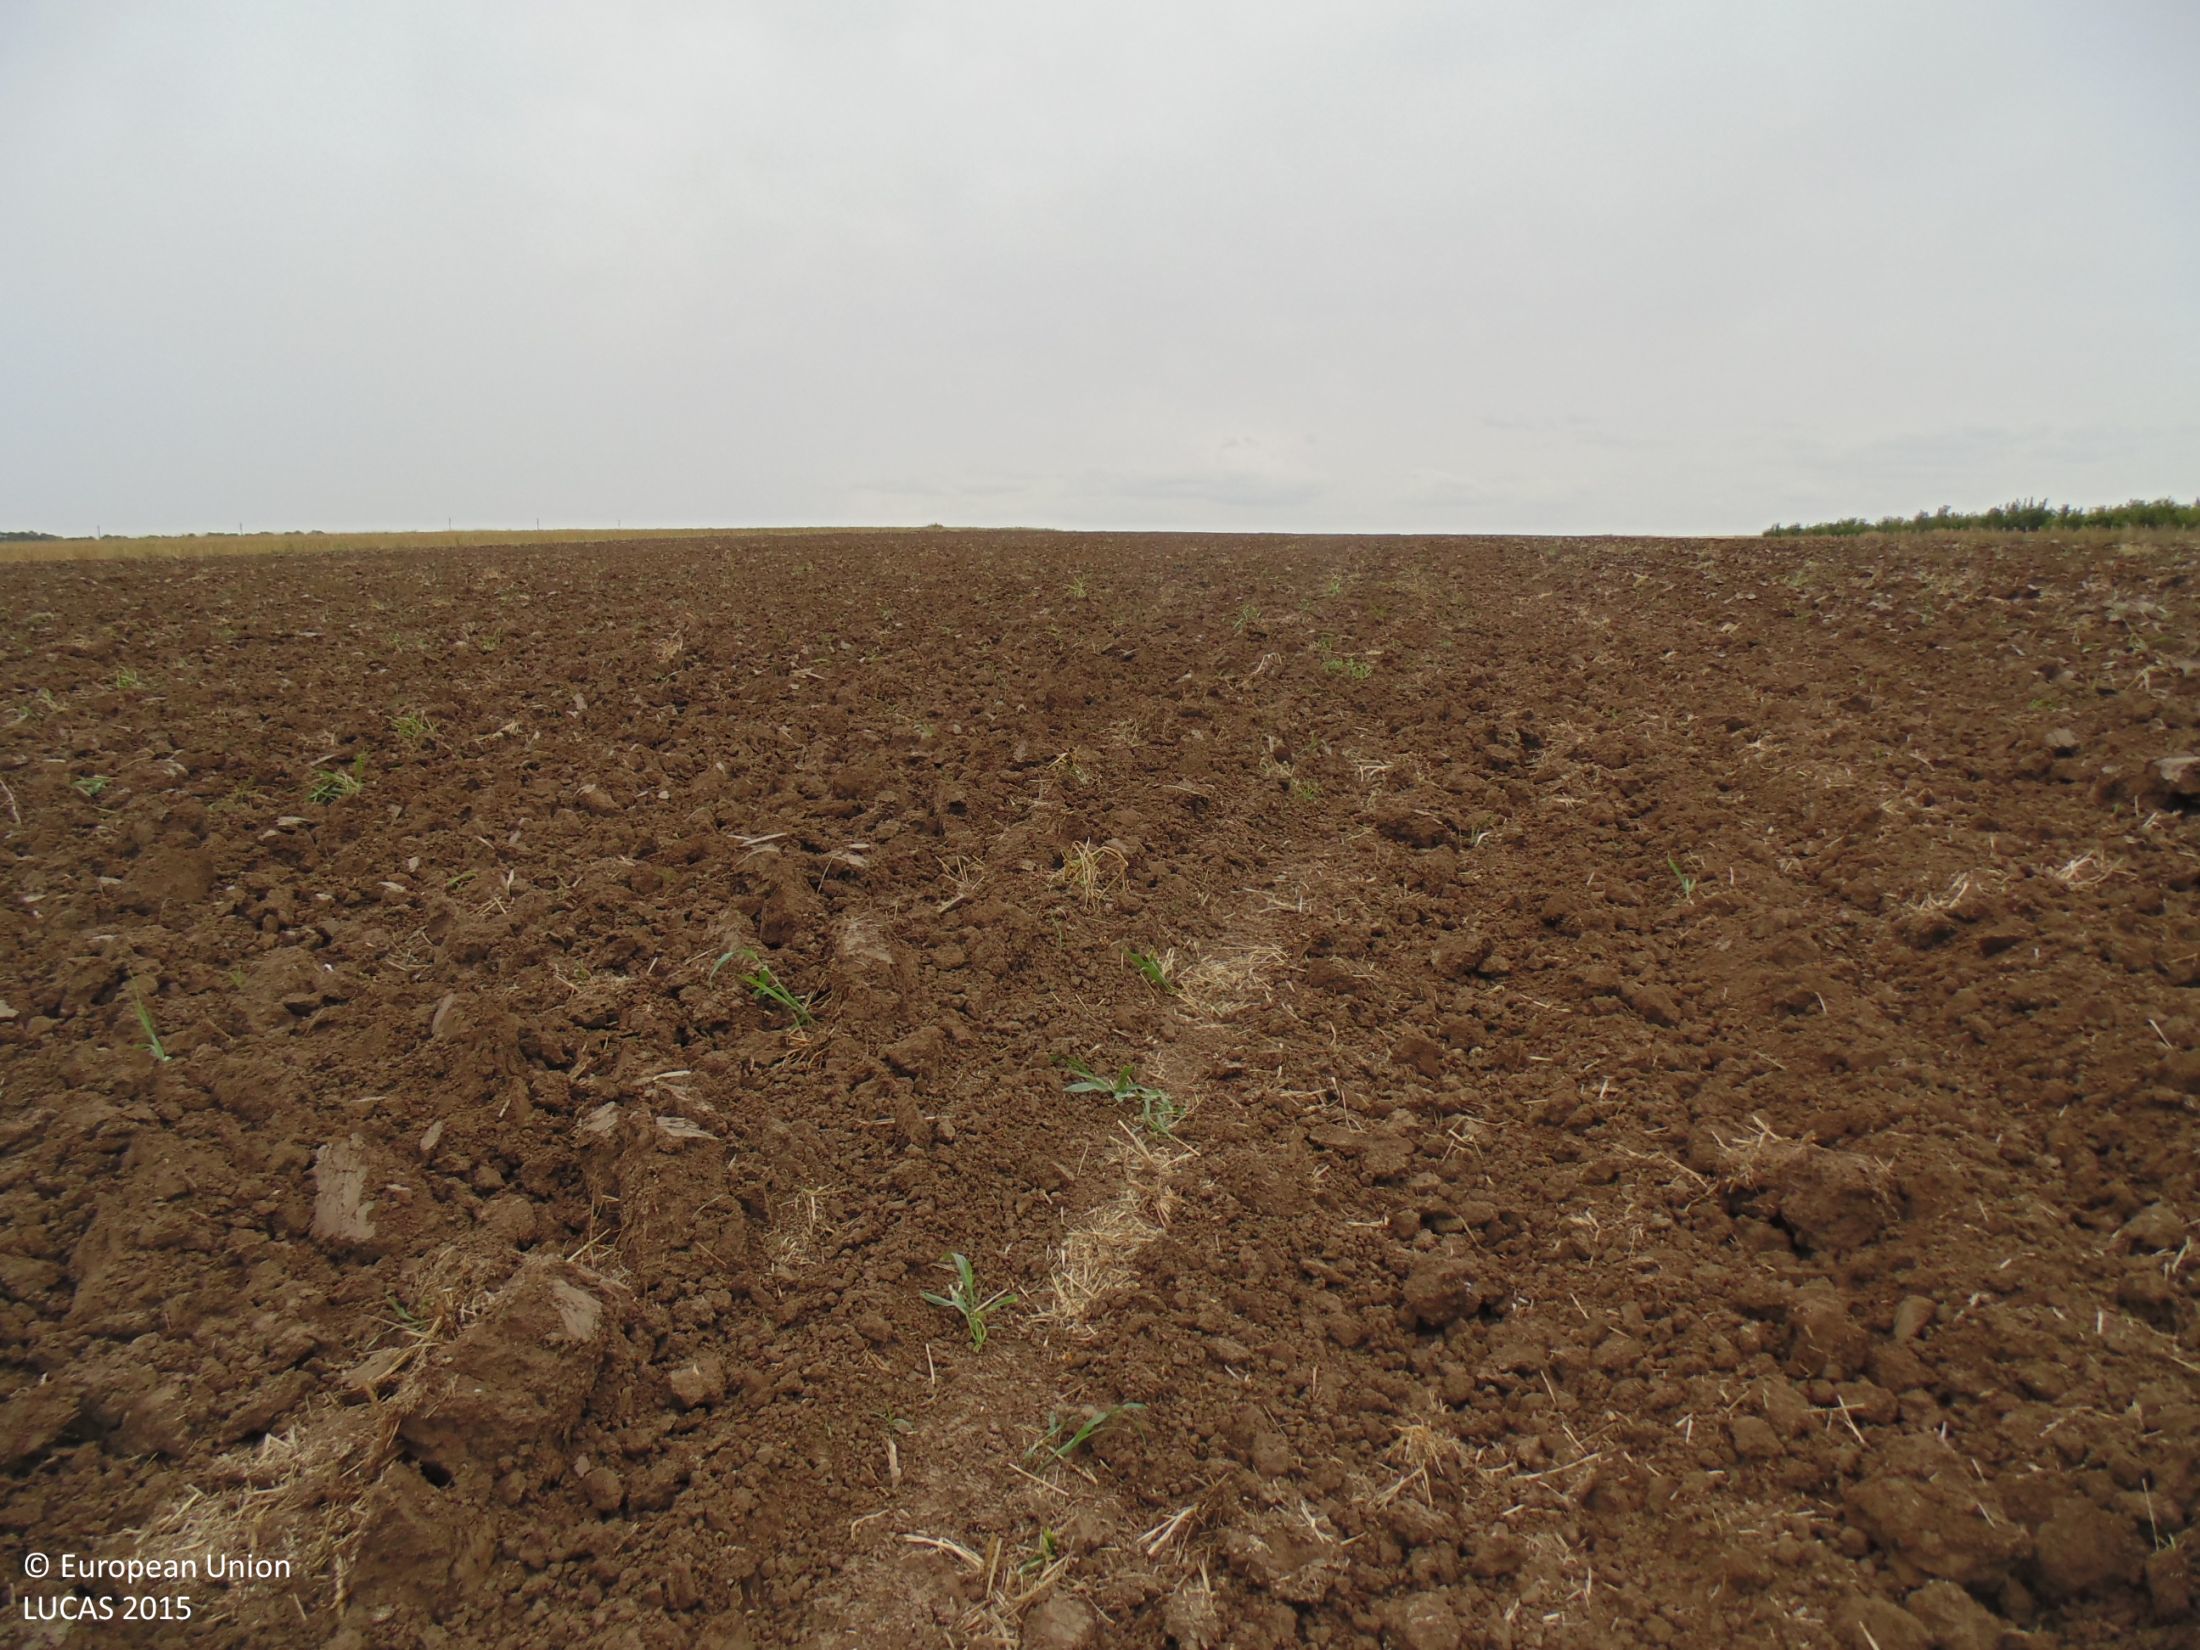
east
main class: Cropland
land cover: Common wheat
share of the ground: < 10 %
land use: Agriculture (excluding fallow land and kitchen gardens)
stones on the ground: < 10 %
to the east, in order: Common wheat
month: September
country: BG
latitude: 43.9504
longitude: 26.9813
